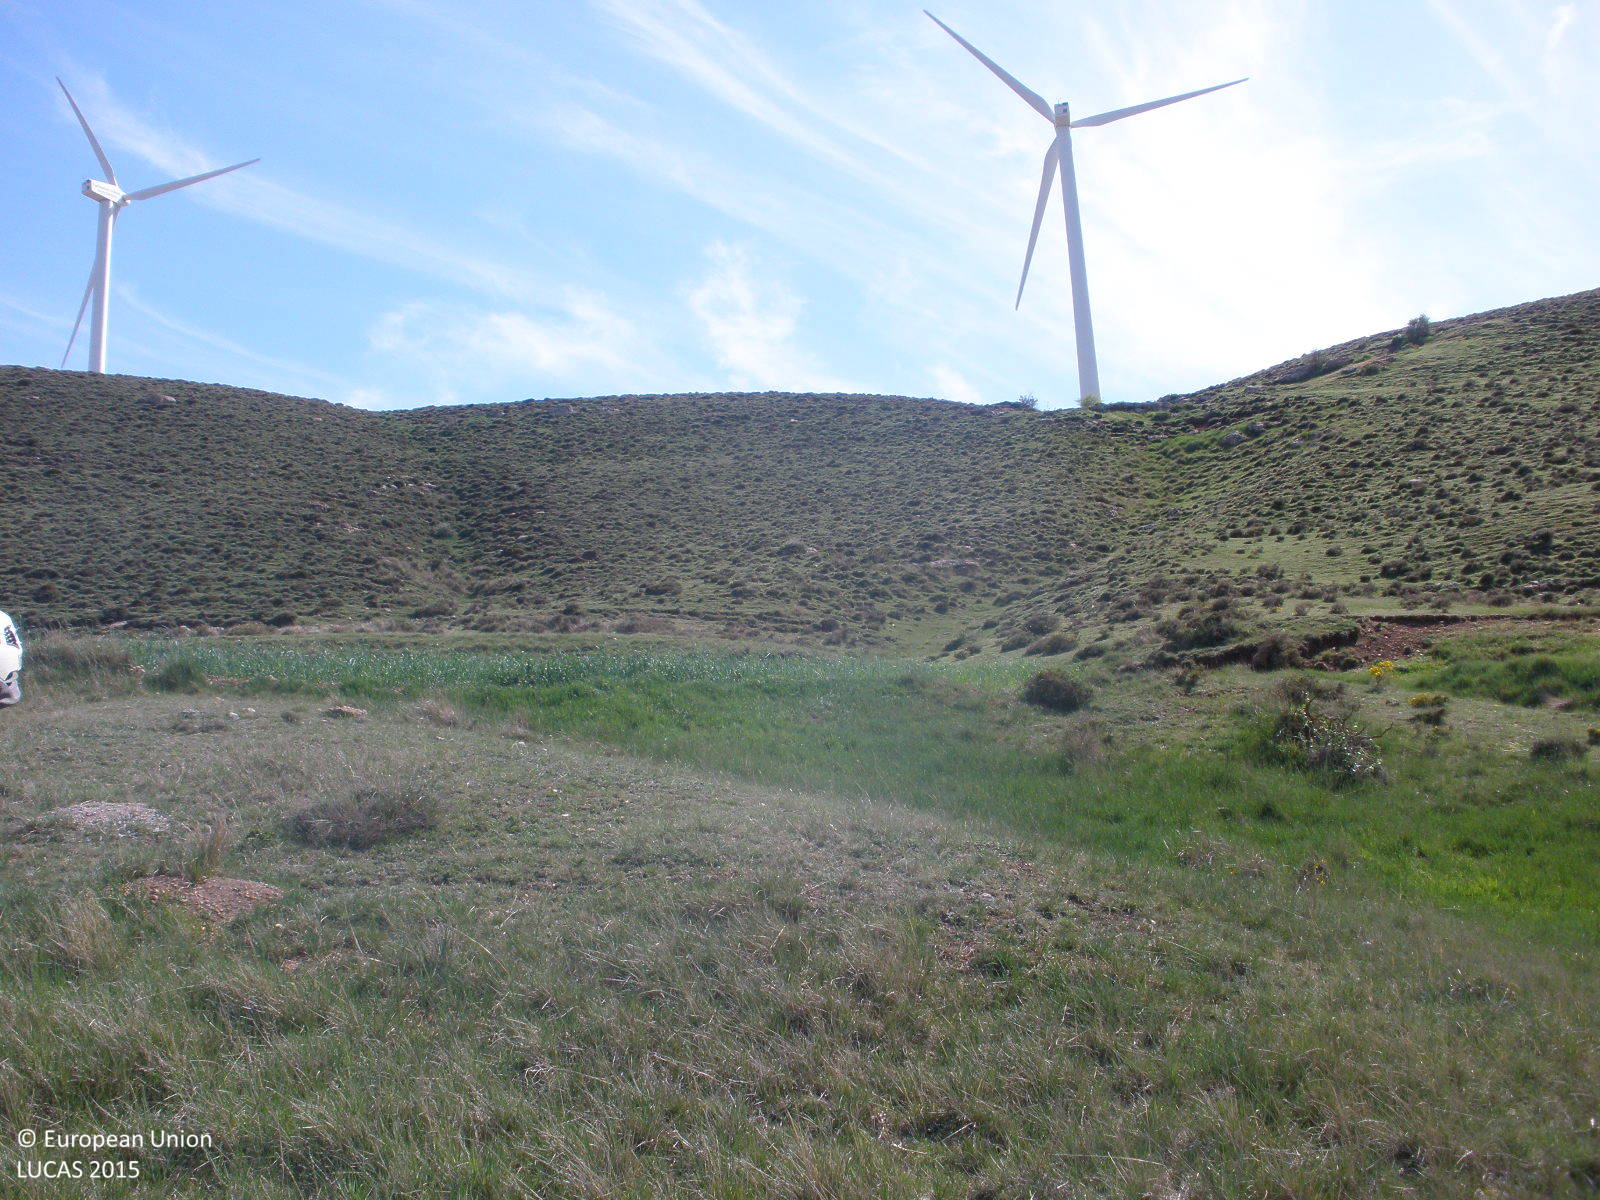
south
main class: Grassland
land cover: Grassland without tree/shrub cover
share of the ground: > 75 %
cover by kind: herbaceous plants 100 %
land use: Semi-natural and natural areas not in use
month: May
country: ES
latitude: 40.7167
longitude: -0.8920
